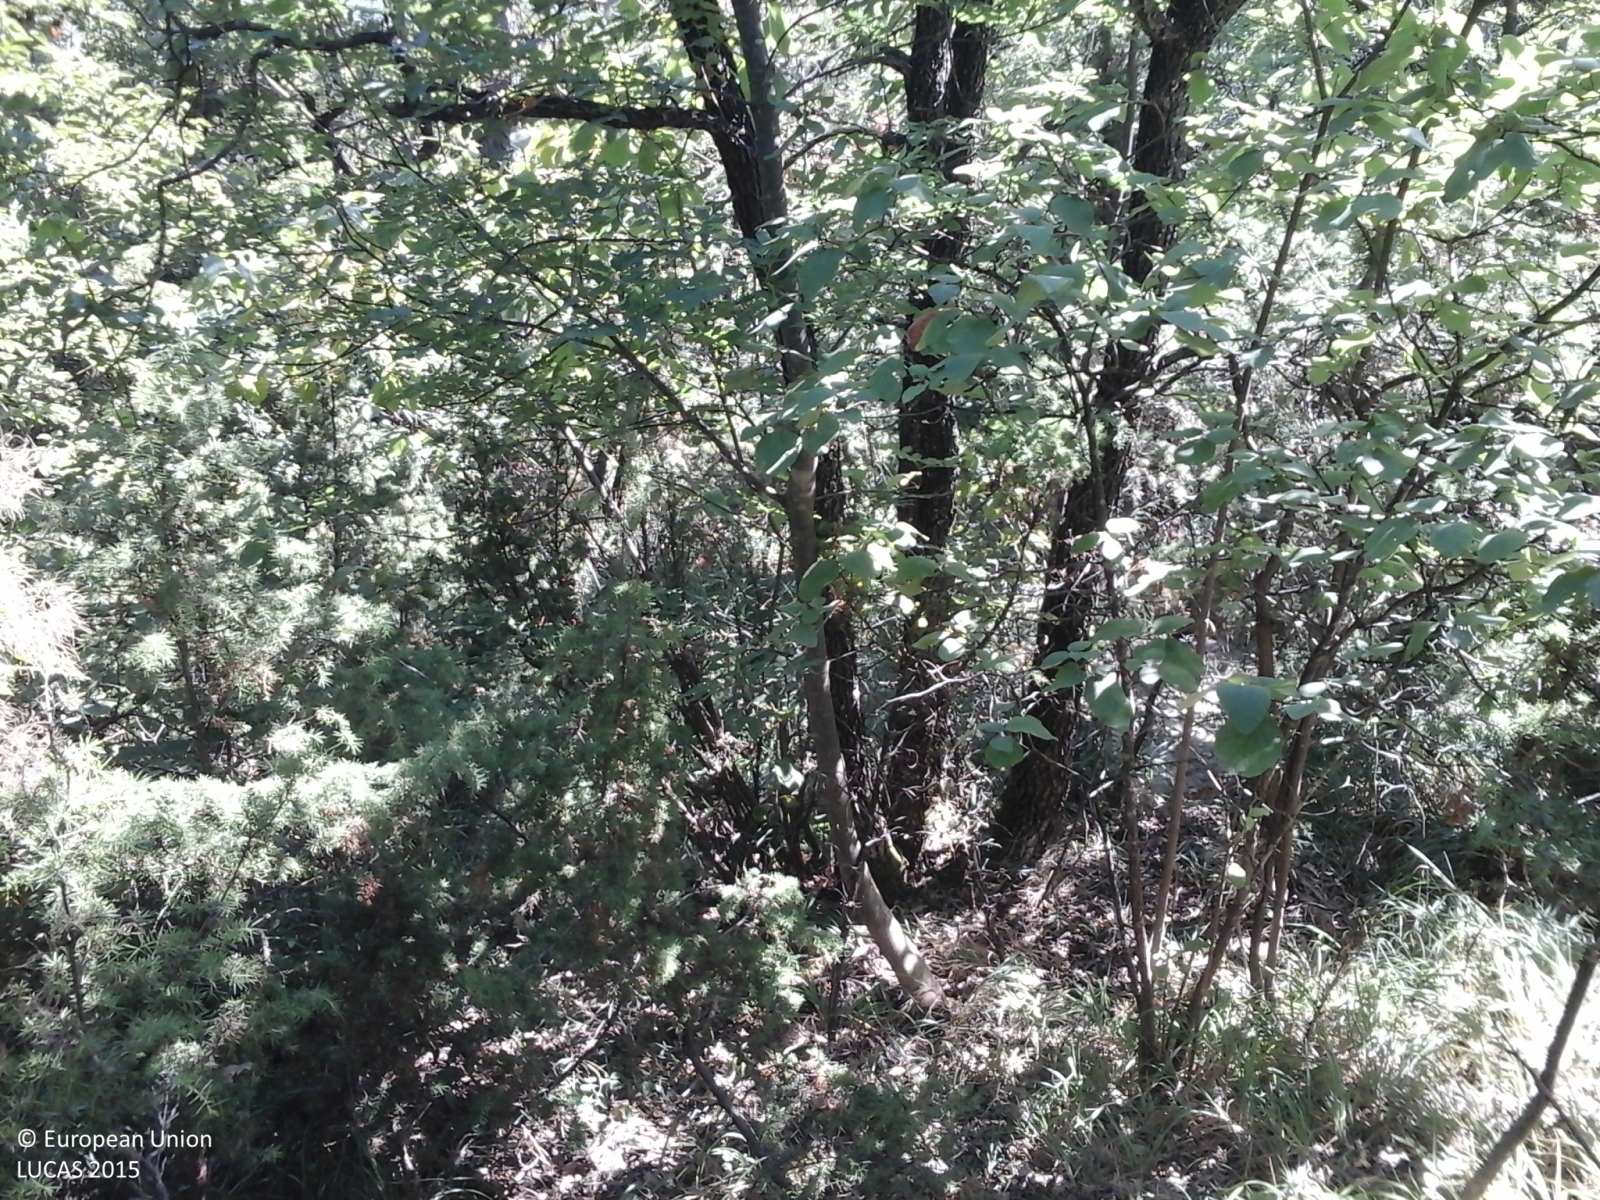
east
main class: Woodland
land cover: Broadleaved woodland
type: thermophilous deciduous forest
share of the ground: > 75 %
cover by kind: broadleaved forest trees 100 %
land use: Forestry
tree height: > 5 m
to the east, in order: Broadleaved woodland
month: August
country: IT
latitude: 44.8156
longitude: 9.1040
